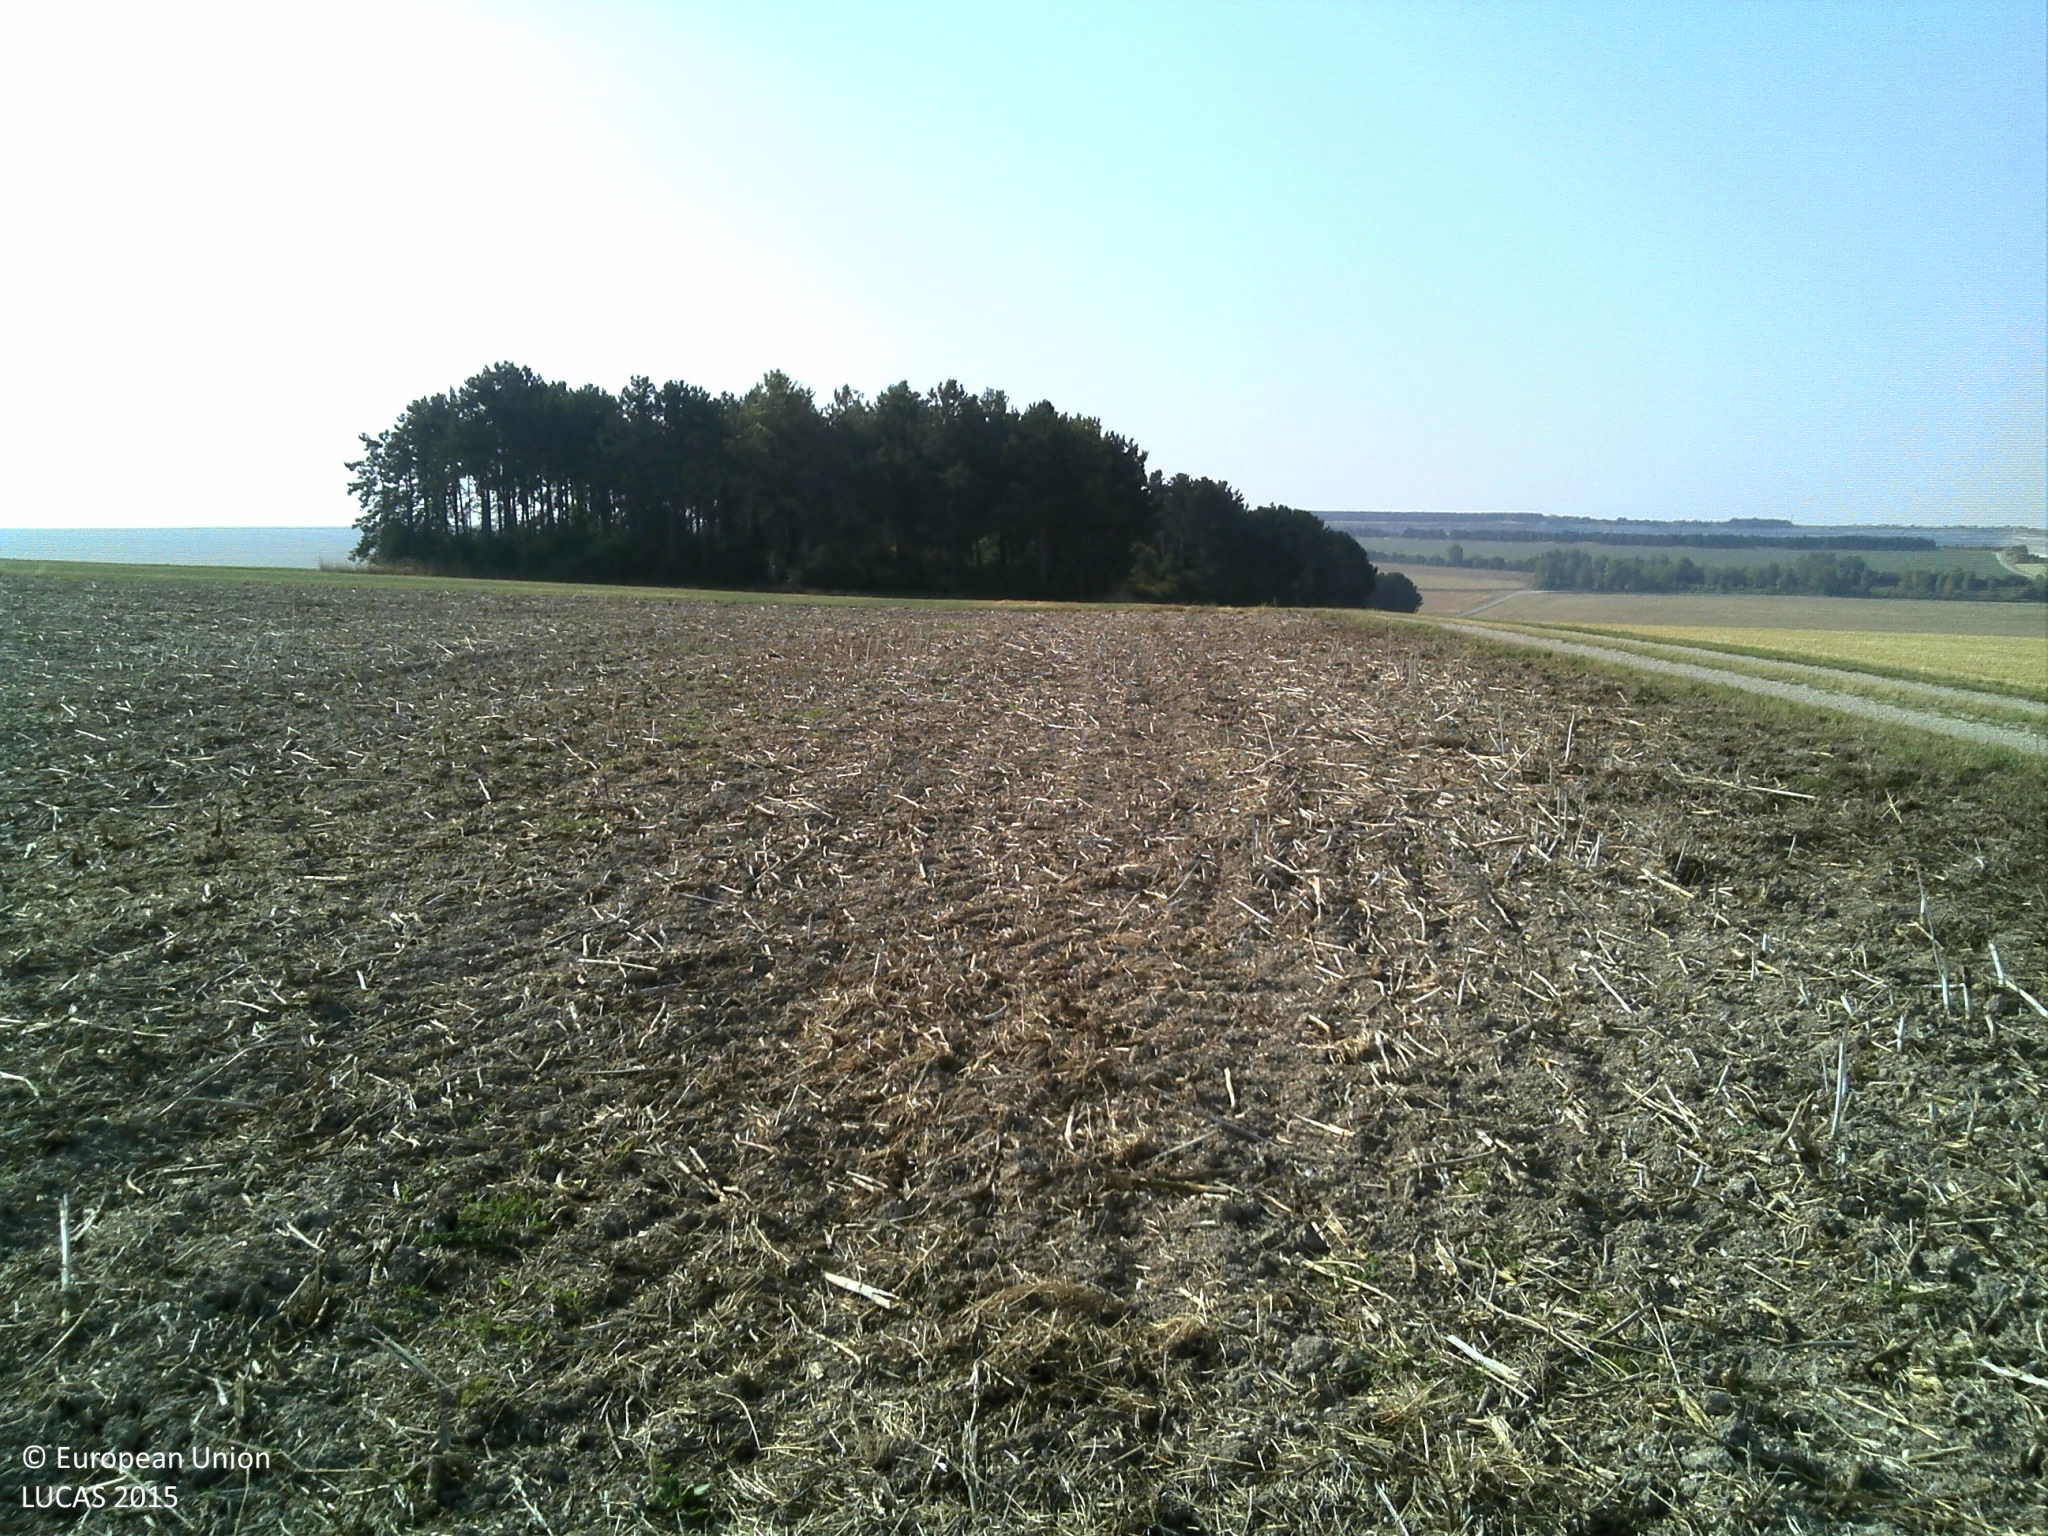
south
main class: Cropland
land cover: Rape and turnip rape
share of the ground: > 75 %
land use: Agriculture (excluding fallow land and kitchen gardens)
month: August
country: FR
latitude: 48.9376
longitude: 4.5772
